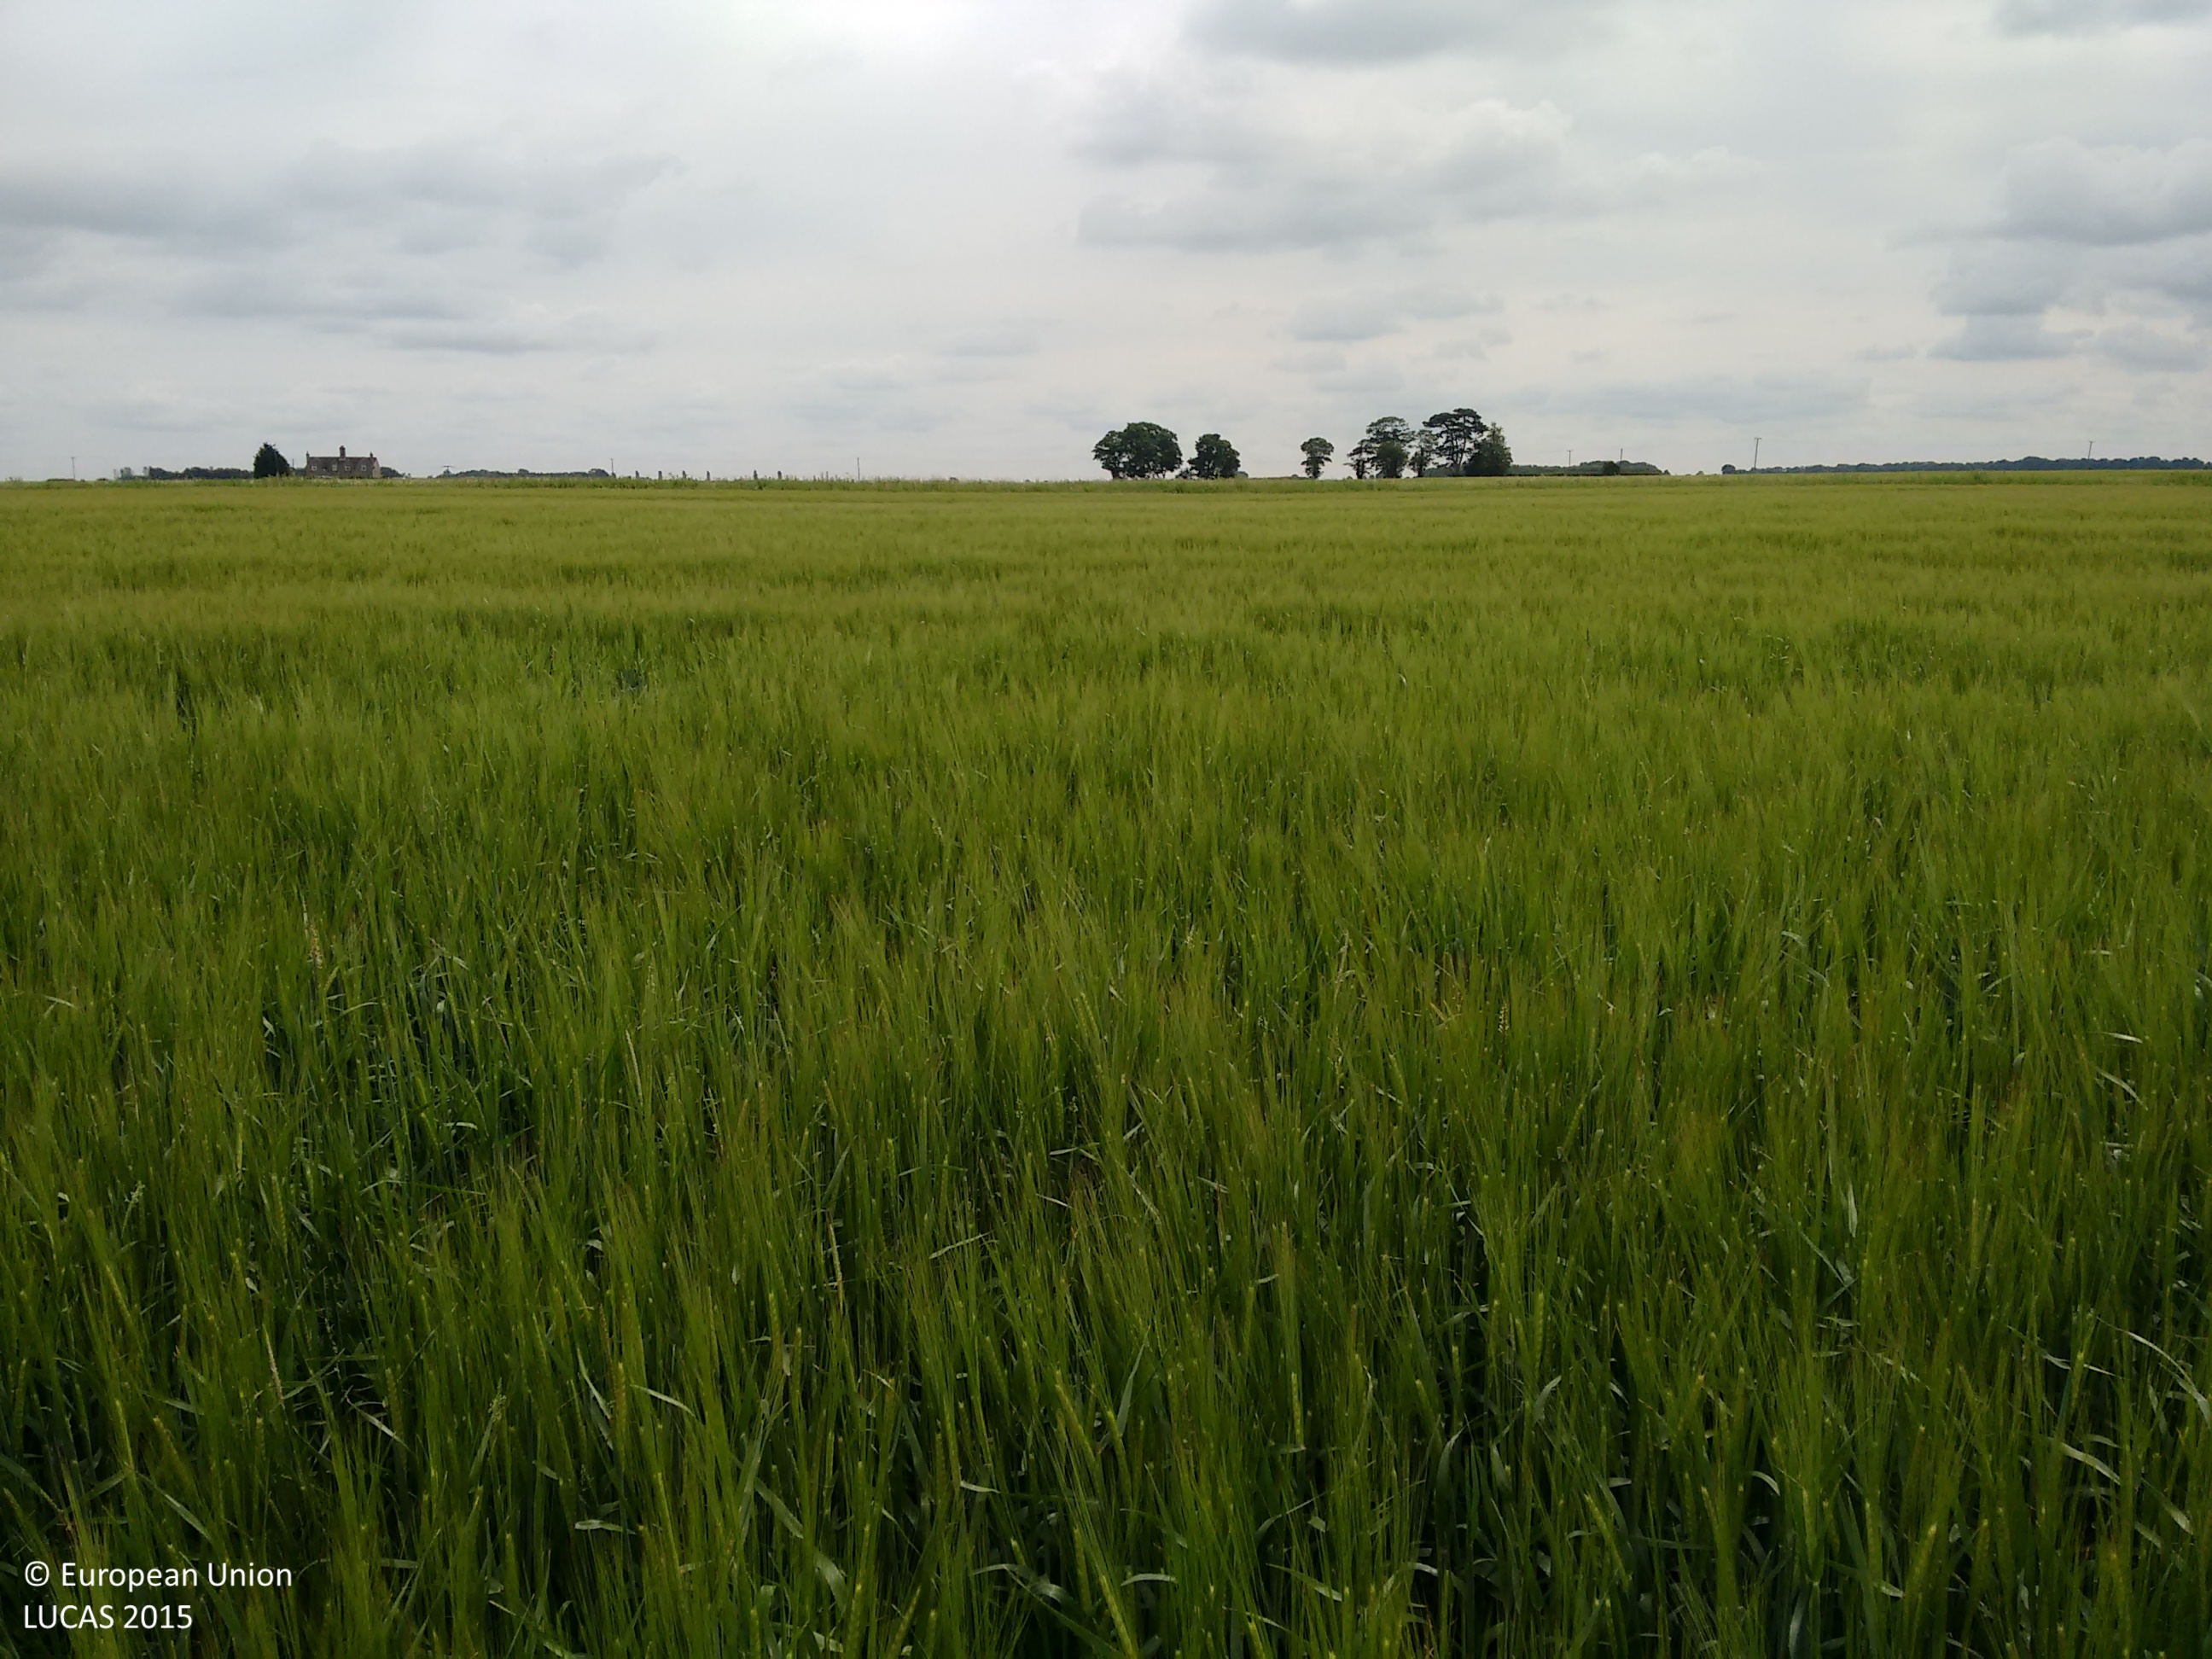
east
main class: Cropland
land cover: Barley
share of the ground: > 75 %
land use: Agriculture (excluding fallow land and kitchen gardens)
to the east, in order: Barley; Grassland without tree/shrub cover; Ditches and canals; Grassland without tree/shrub cover; Barley
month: June
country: GB
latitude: 52.6371
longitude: -0.0666
